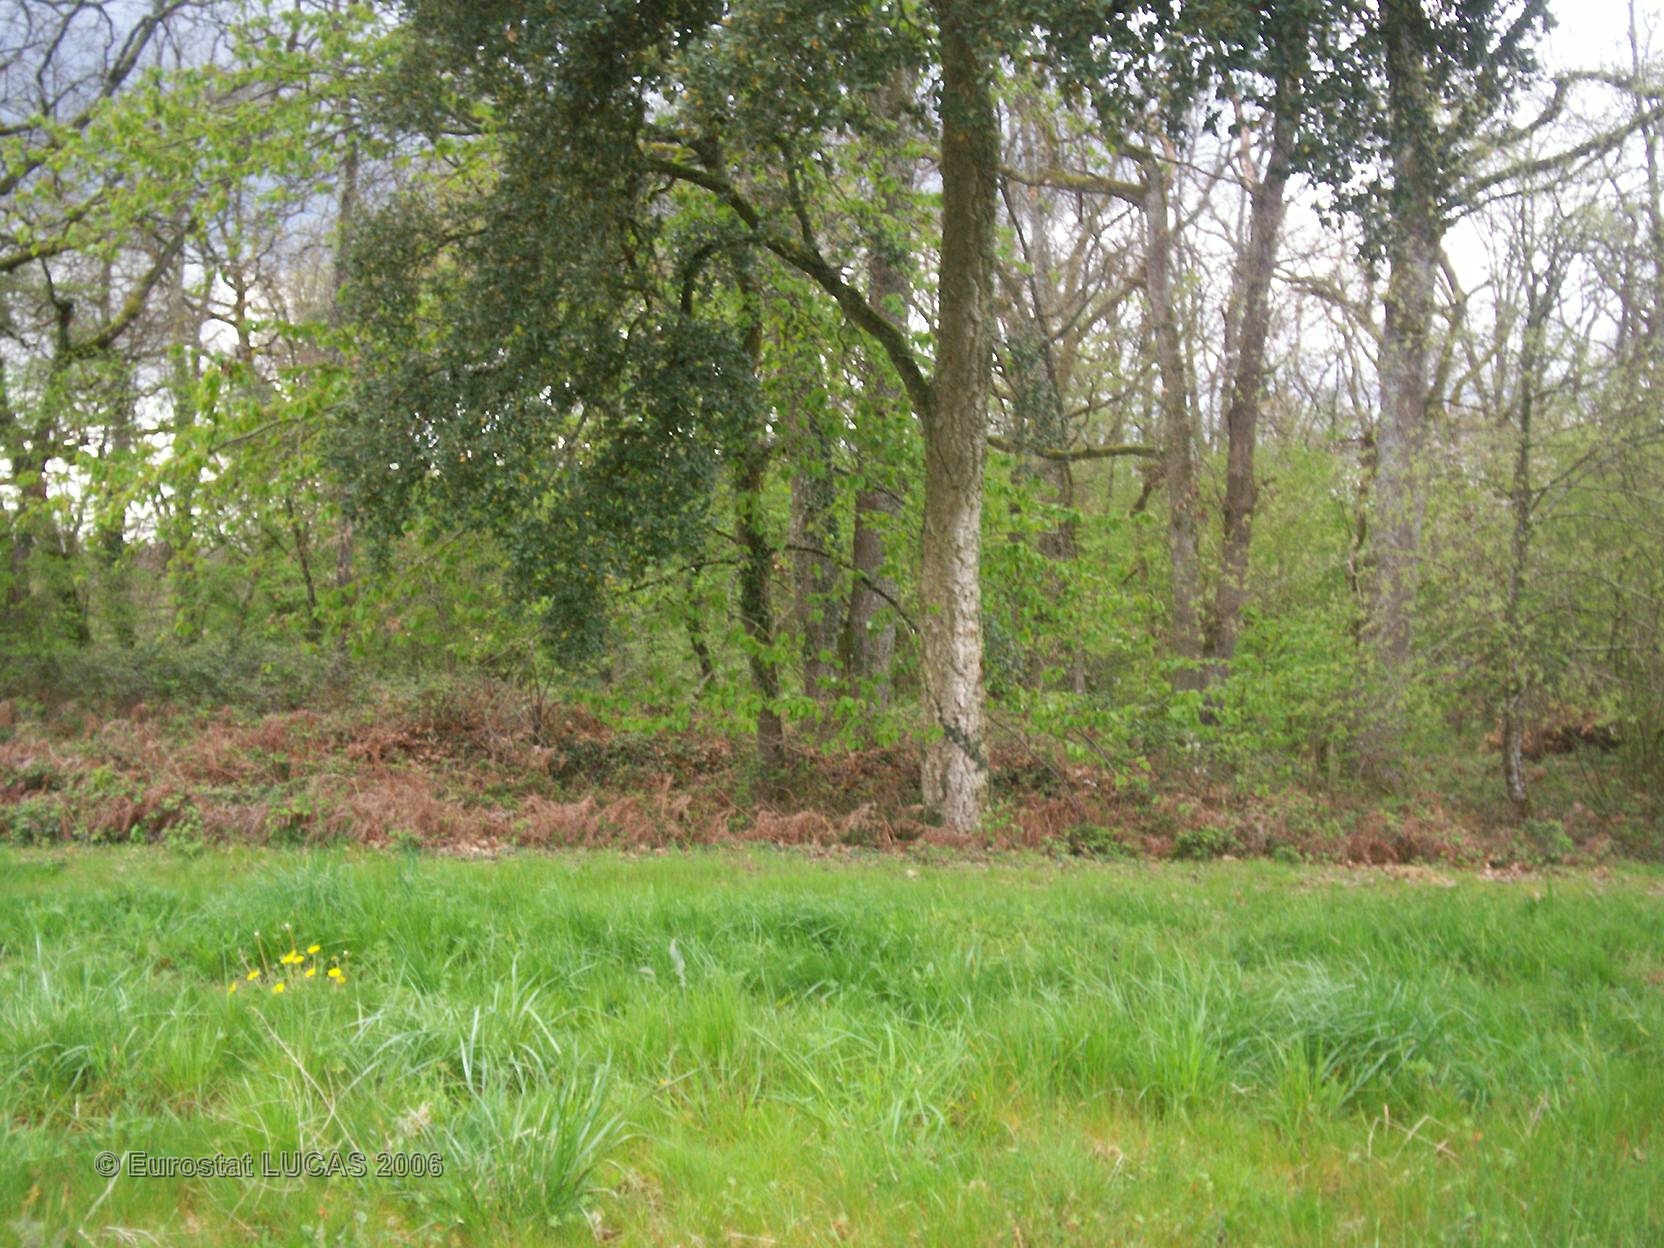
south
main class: Grassland
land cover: Grassland with sparse tree/shrub cover
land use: Agriculture (excluding fallow land and kitchen gardens)
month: April
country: FR
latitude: 43.9903
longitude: 0.1548
